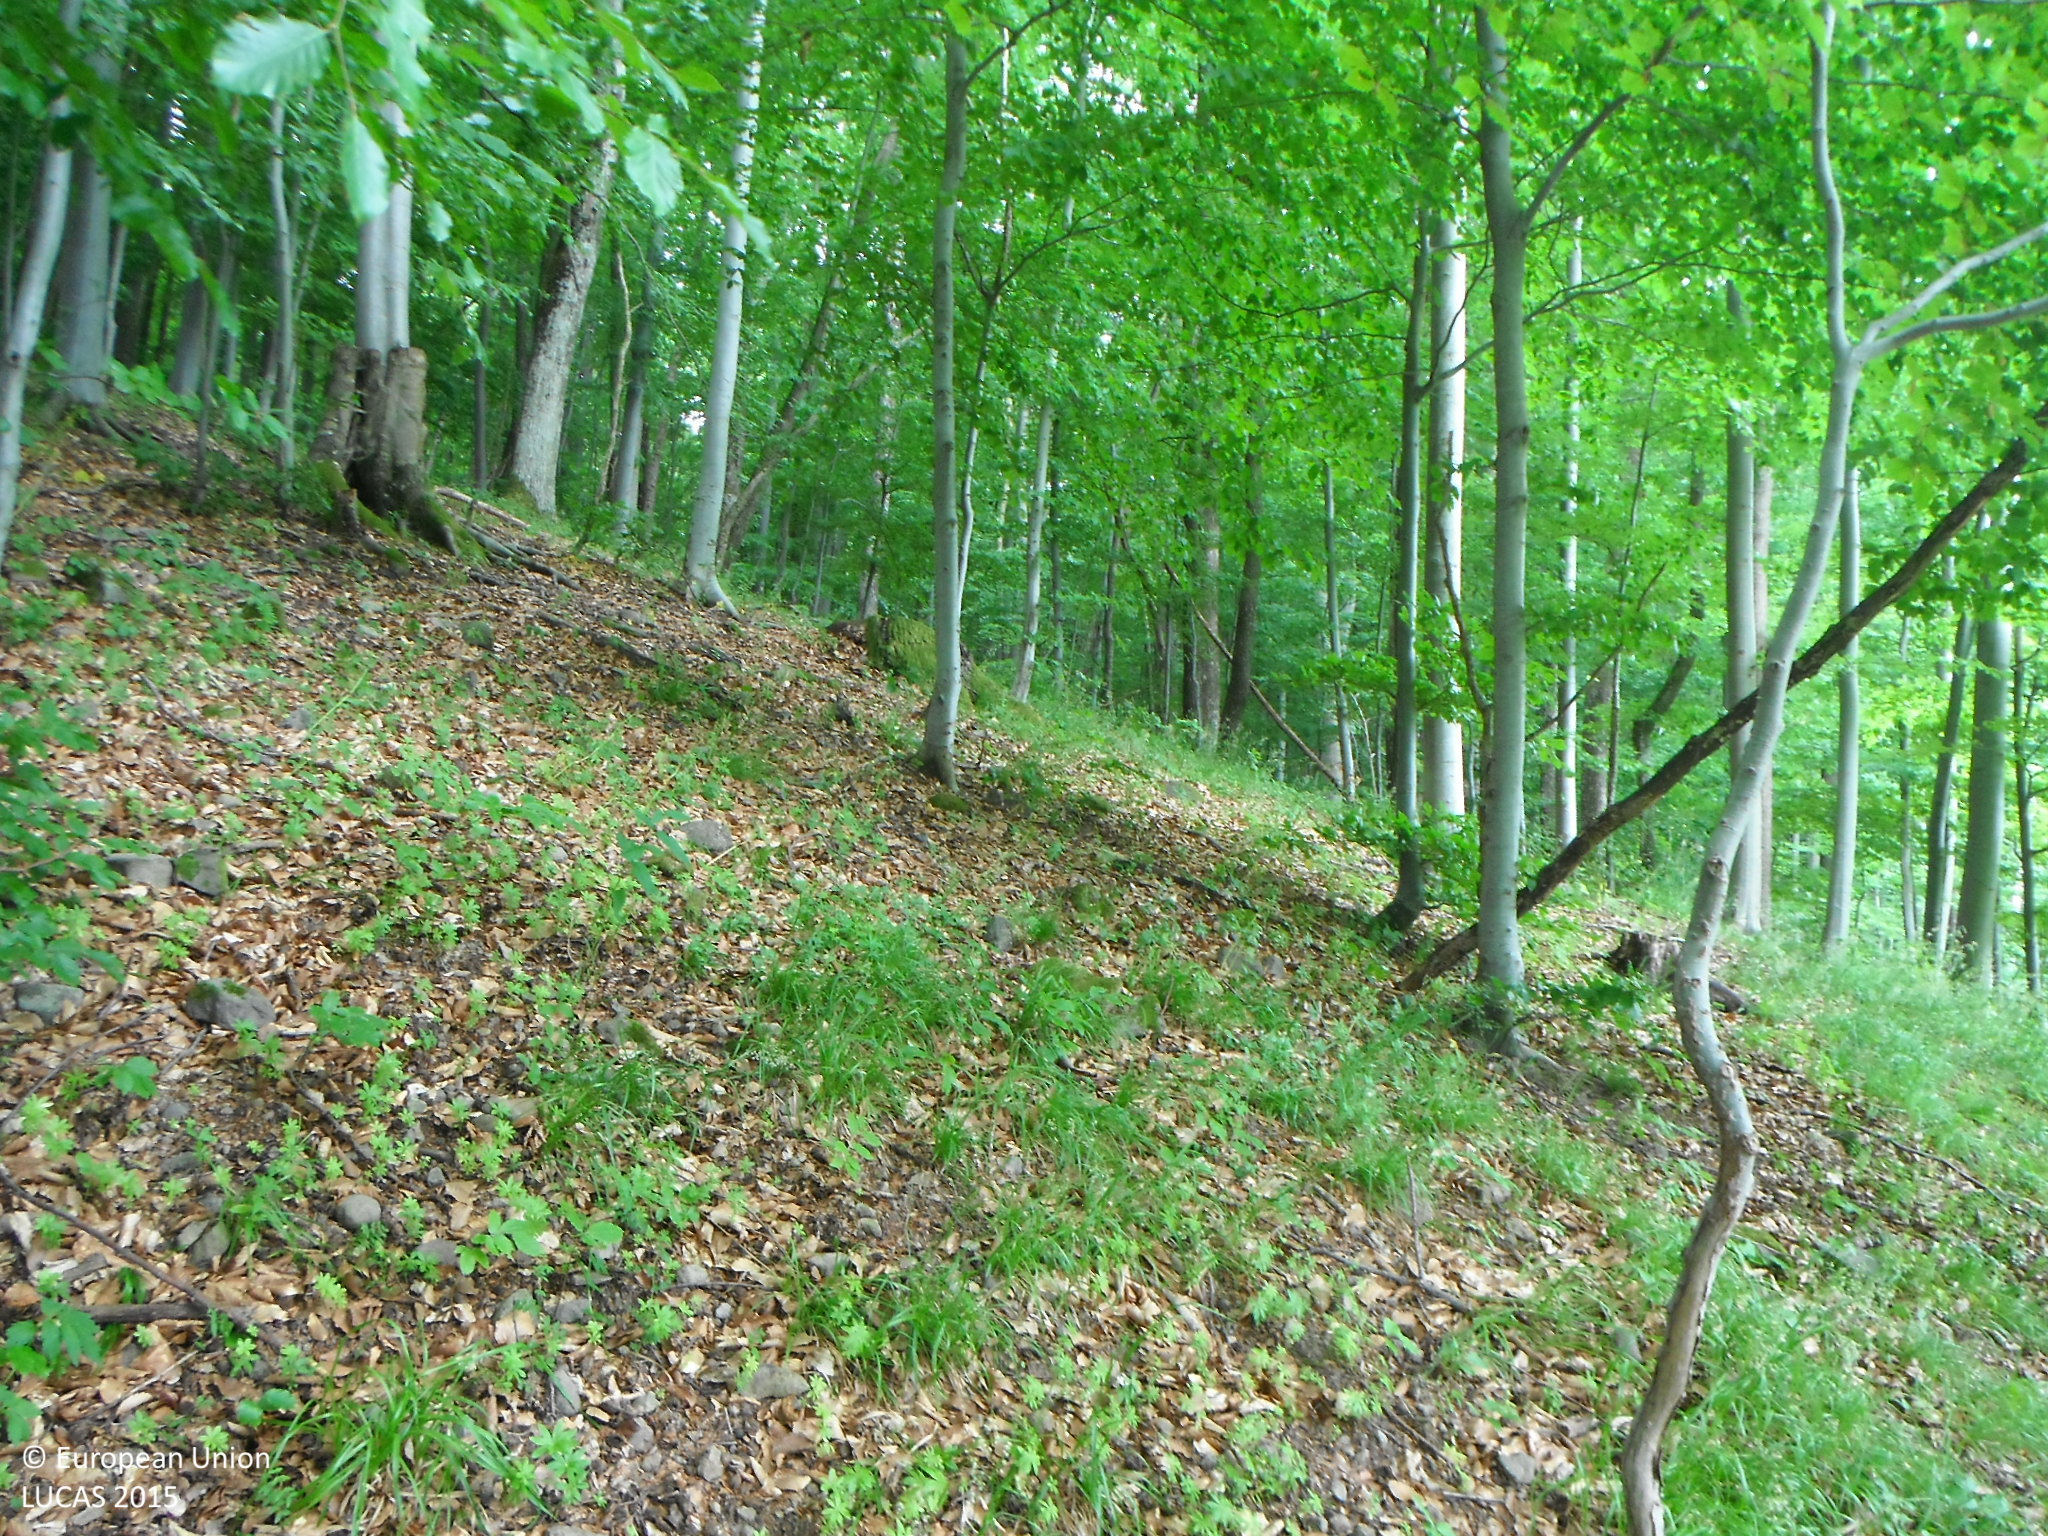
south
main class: Woodland
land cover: Broadleaved woodland
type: mountainous beech forest
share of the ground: > 75 %
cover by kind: broadleaved forest trees 90 %, herbaceous plants 10 %
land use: Forestry
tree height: > 5 m
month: June
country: SK
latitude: 48.6429
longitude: 19.3204
